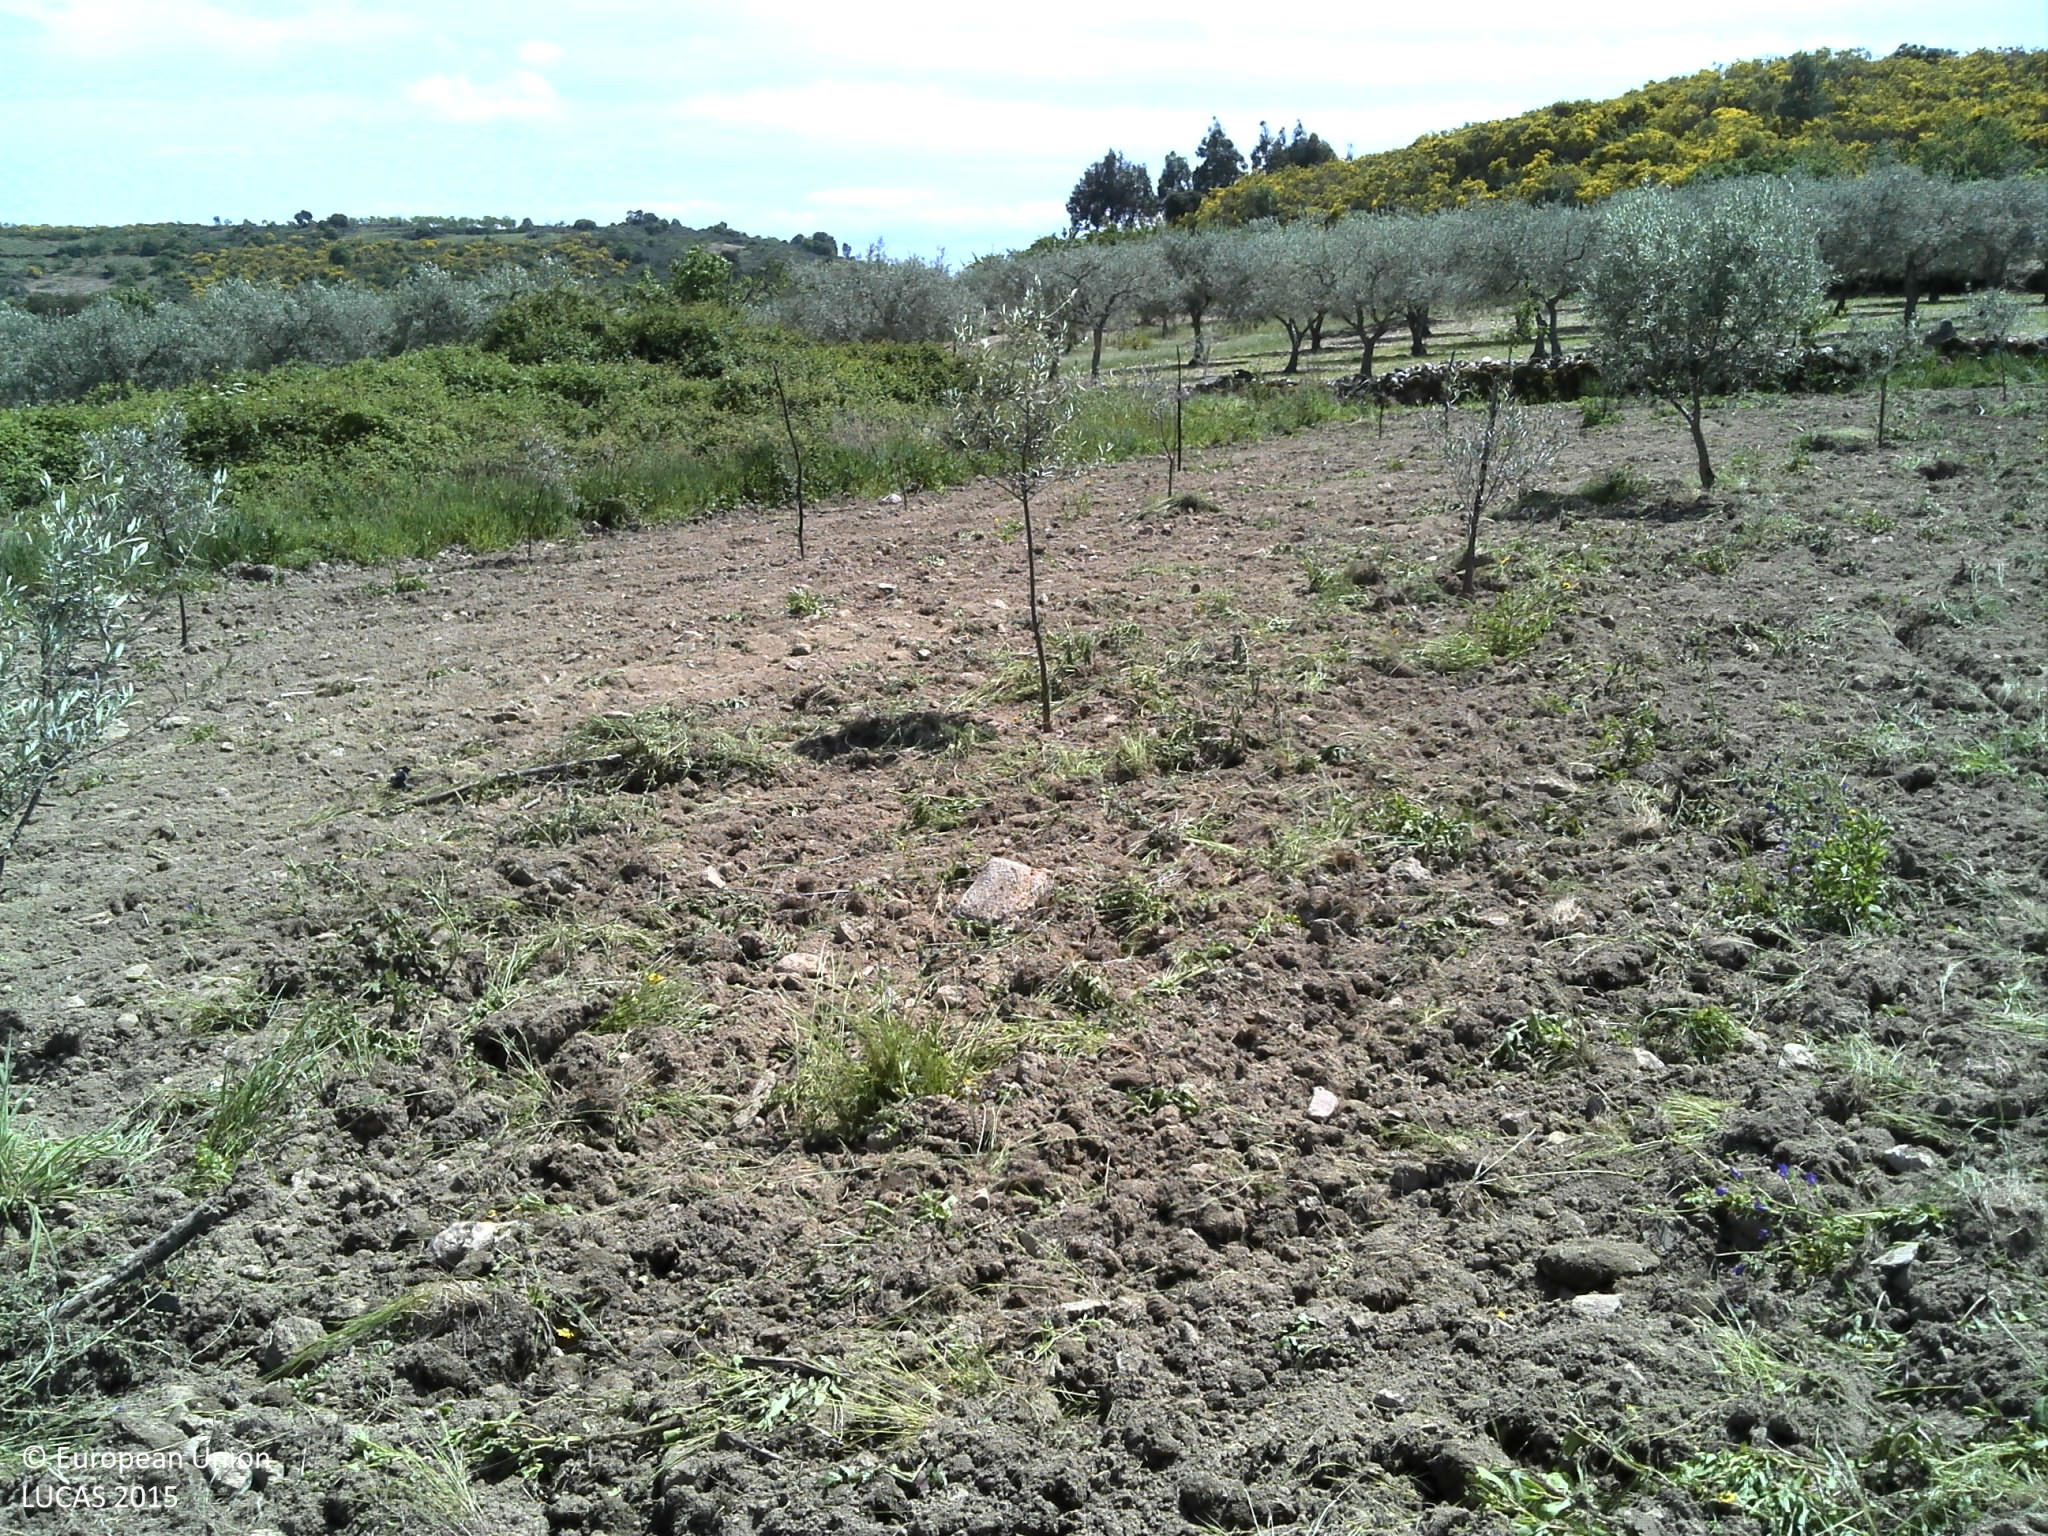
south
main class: Cropland
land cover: Olive groves
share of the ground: < 10 %
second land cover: Spontaneously vegetated surfaces
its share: < 10 %
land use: Agriculture (excluding fallow land and kitchen gardens)
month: May
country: PT
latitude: 41.7069
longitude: -7.0767
